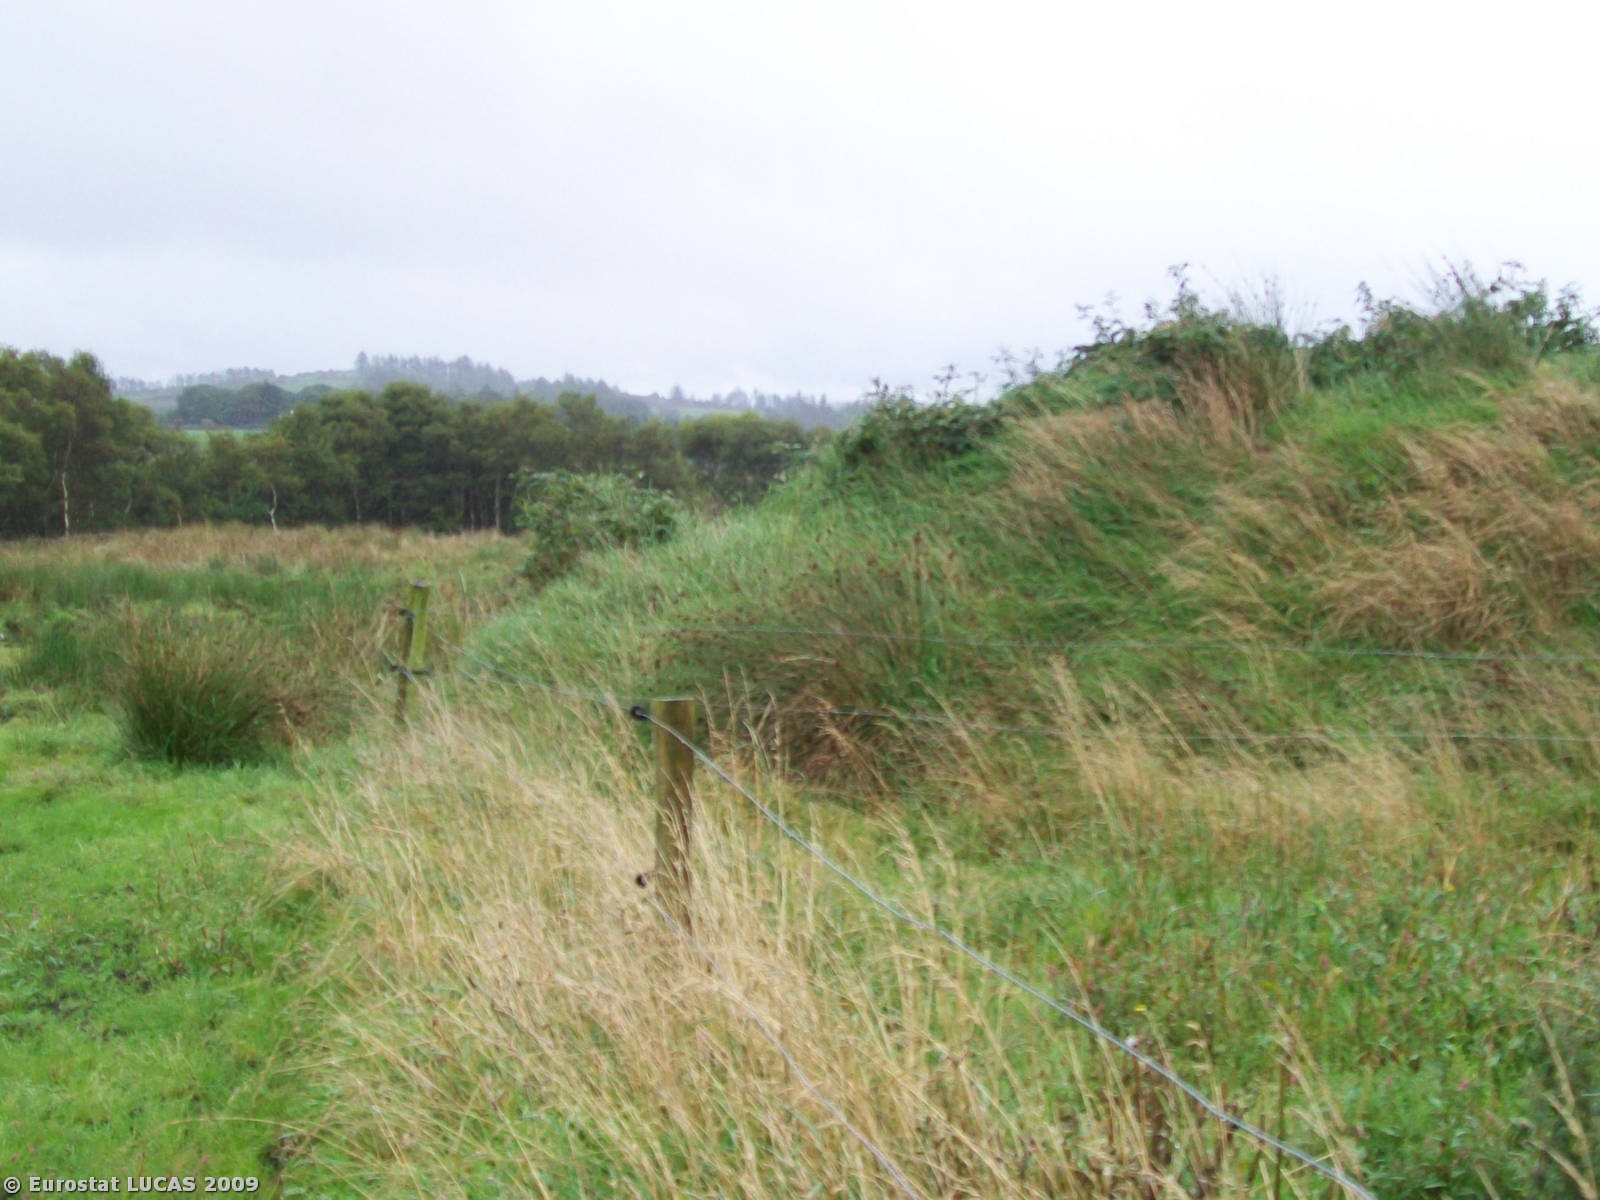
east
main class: Grassland
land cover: Grassland without tree/shrub cover
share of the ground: > 75 %
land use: Agriculture (excluding fallow land and kitchen gardens)
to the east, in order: Grassland without tree/shrub cover; Abandoned hedges; Grassland without tree/shrub cover; Dry stone walls; Grassland without tree/shrub cover; Inland marshes; Mixed woodland; Inland marshes; Inland running water; Mixed woodland
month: August
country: IE
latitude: 52.9106
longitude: -9.2410
